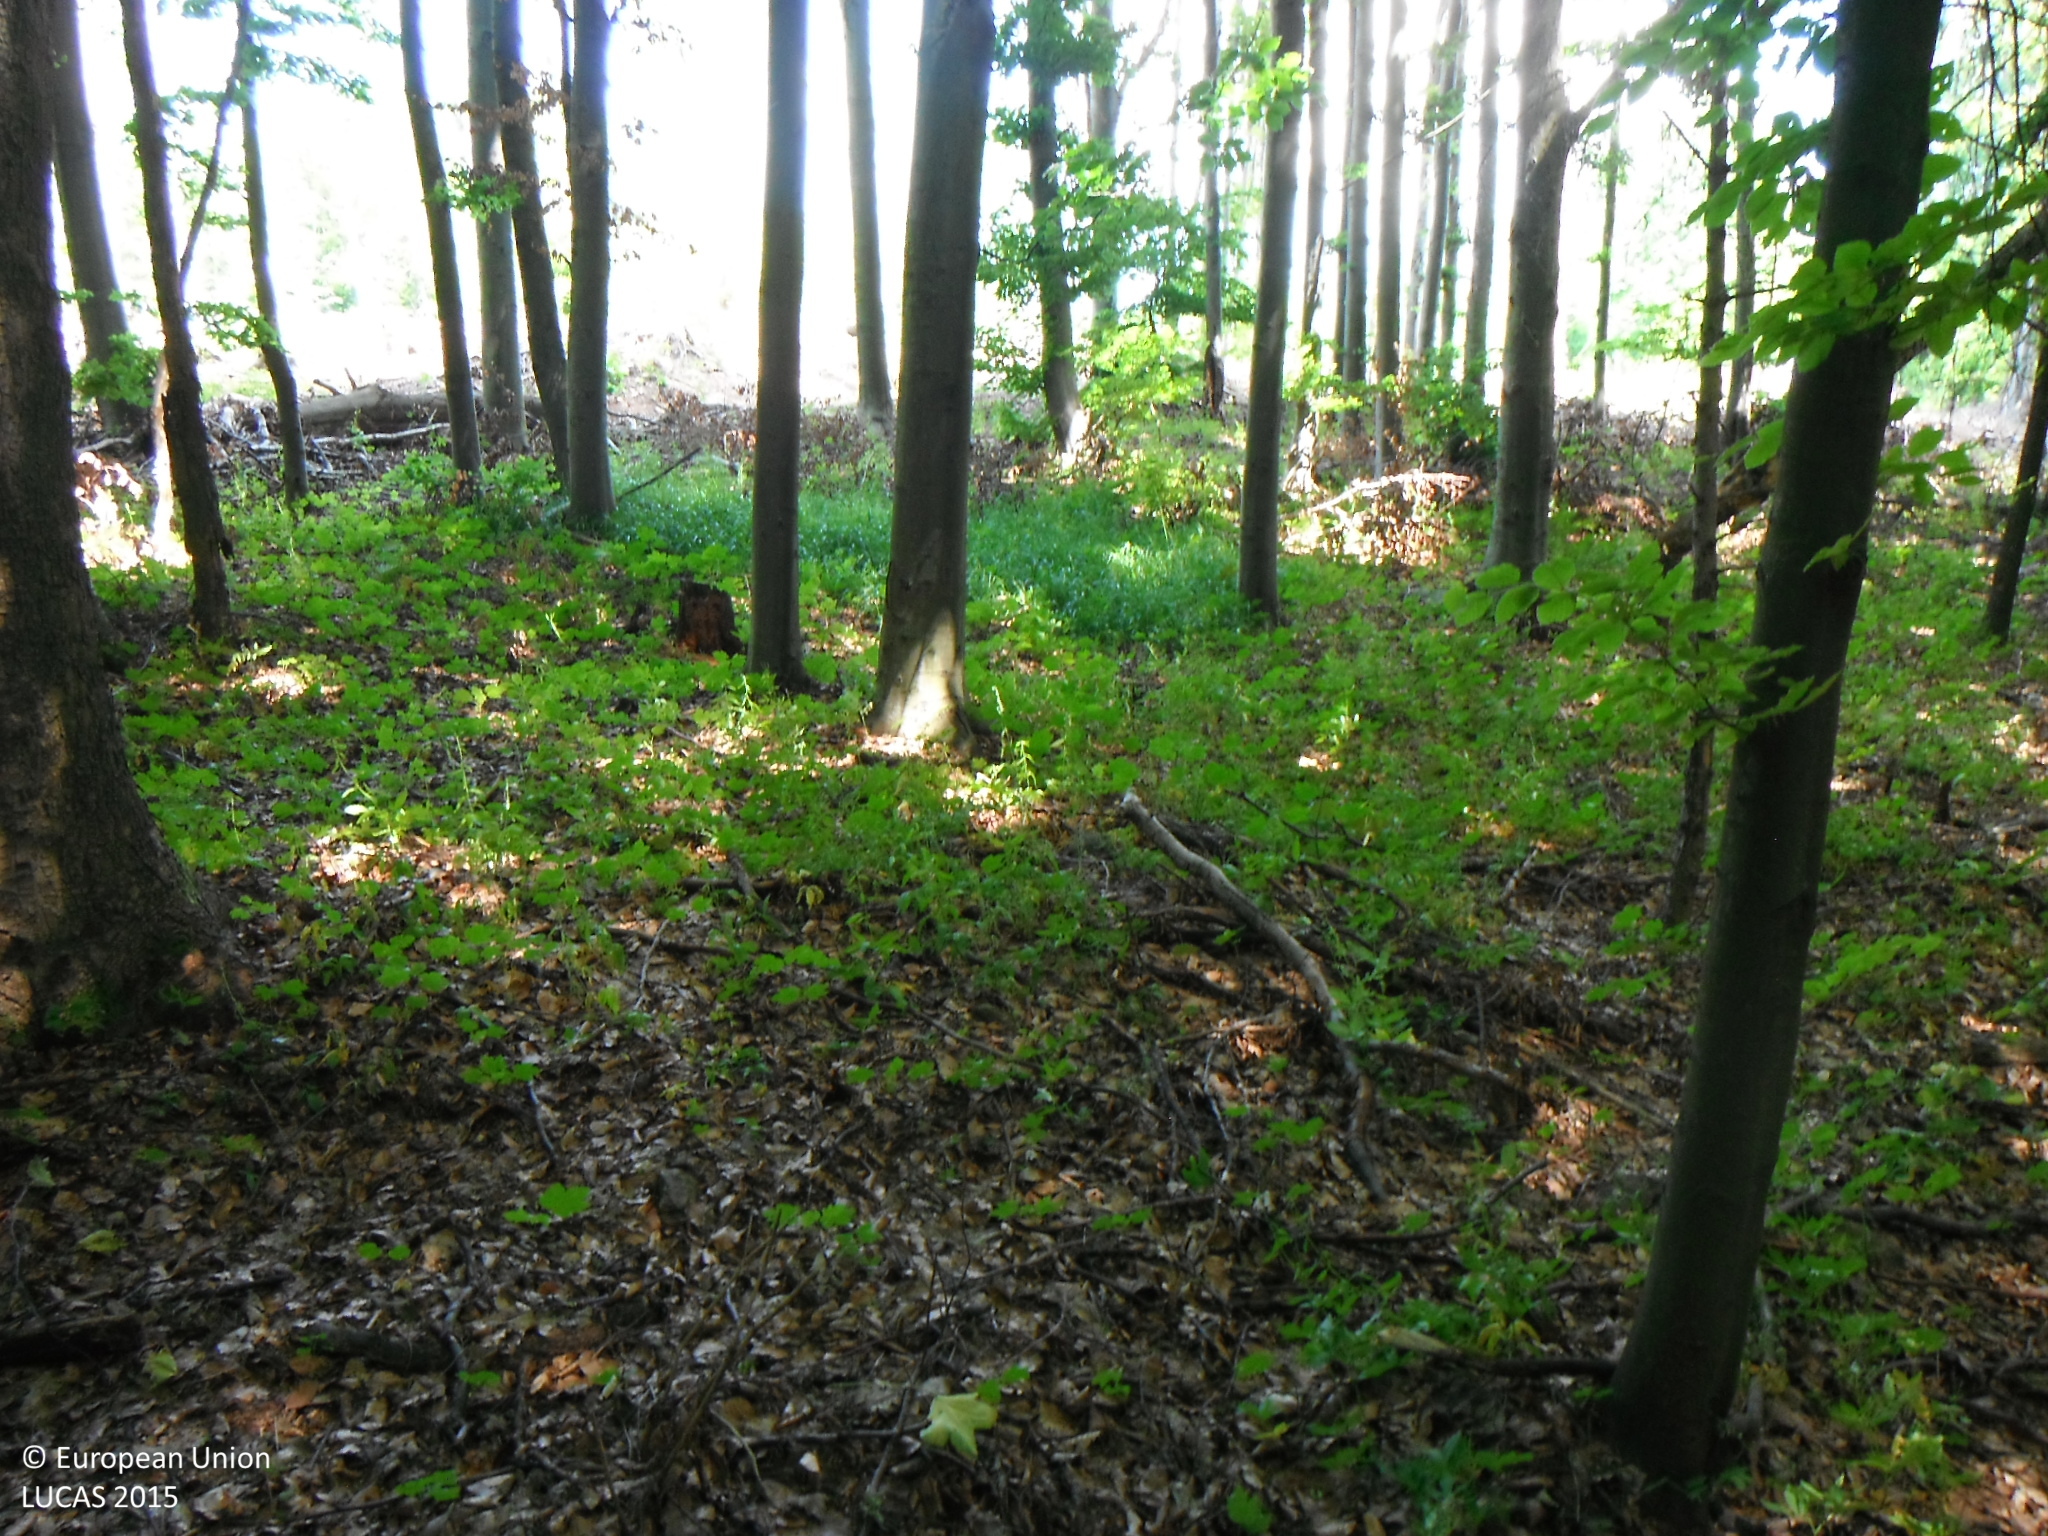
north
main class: Woodland
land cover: Broadleaved woodland
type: mountainous beech forest
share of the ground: > 75 %
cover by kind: broadleaved forest trees 85 %, coniferous forest trees 10 %, herbaceous plants 5 %
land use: Forestry
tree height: > 5 m
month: June
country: SK
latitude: 48.5322
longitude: 19.7642
